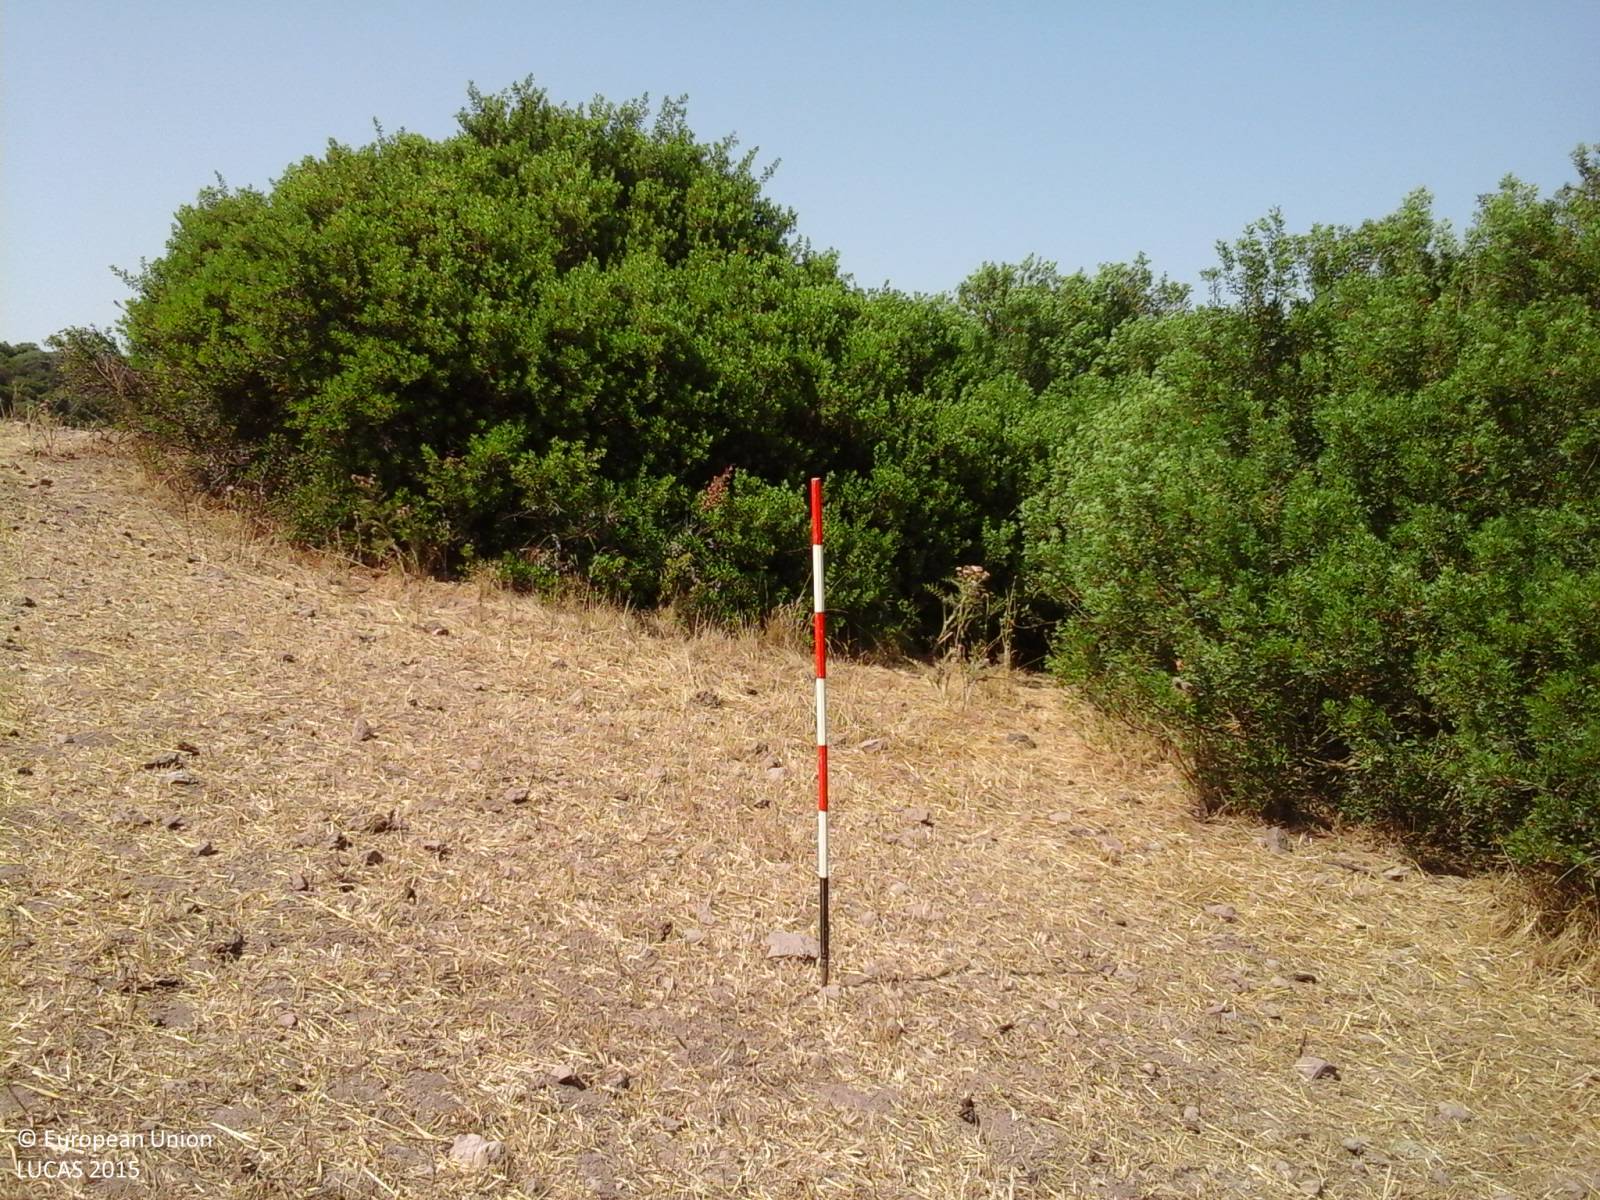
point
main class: Cropland
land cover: Mixed cereals for fodder
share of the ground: > 75 %
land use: Agriculture (excluding fallow land and kitchen gardens)
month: July
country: IT
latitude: 39.9890
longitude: 8.8469
